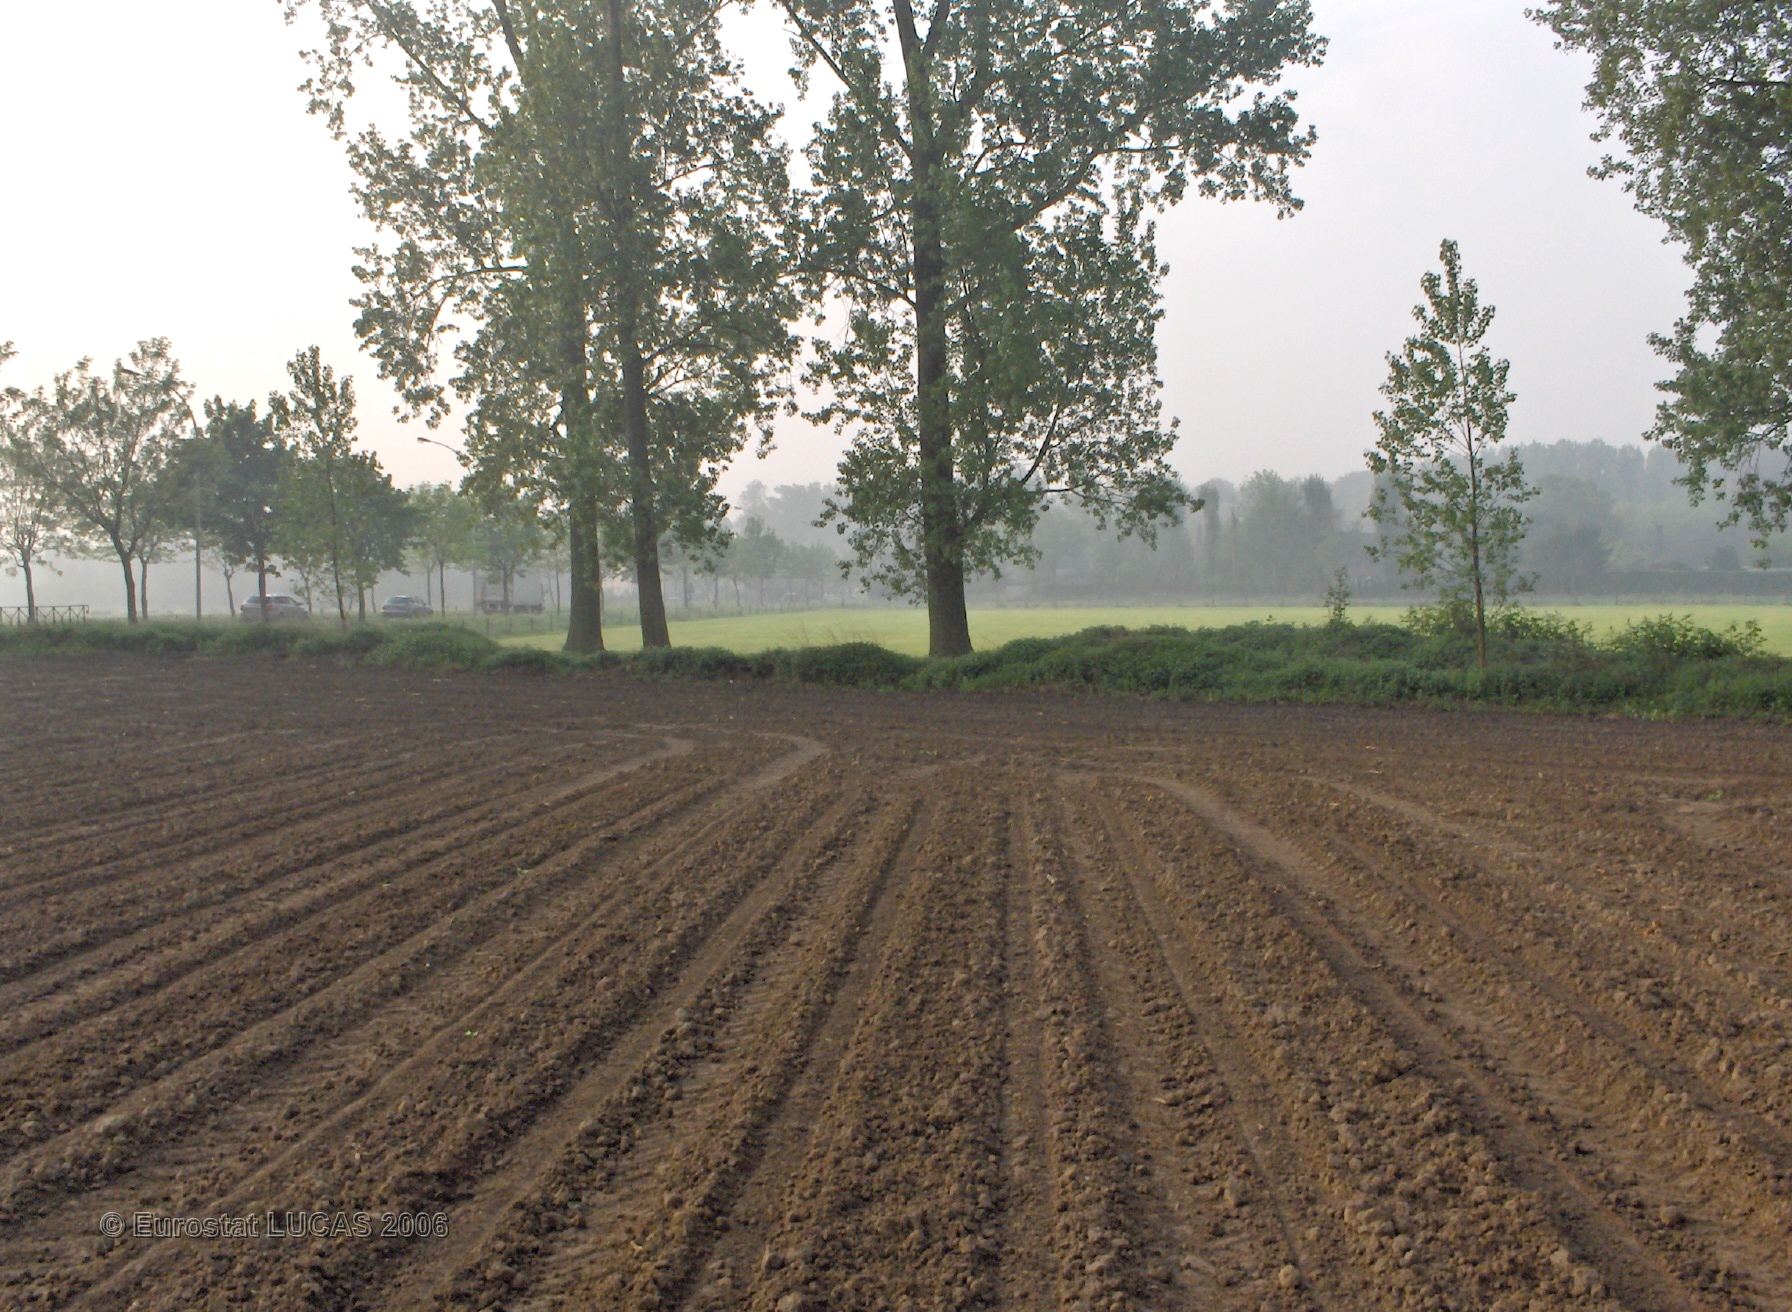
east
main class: Cropland
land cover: Maize
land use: Agriculture (excluding fallow land and kitchen gardens)
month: May
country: BE
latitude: 51.1464
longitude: 4.4062
